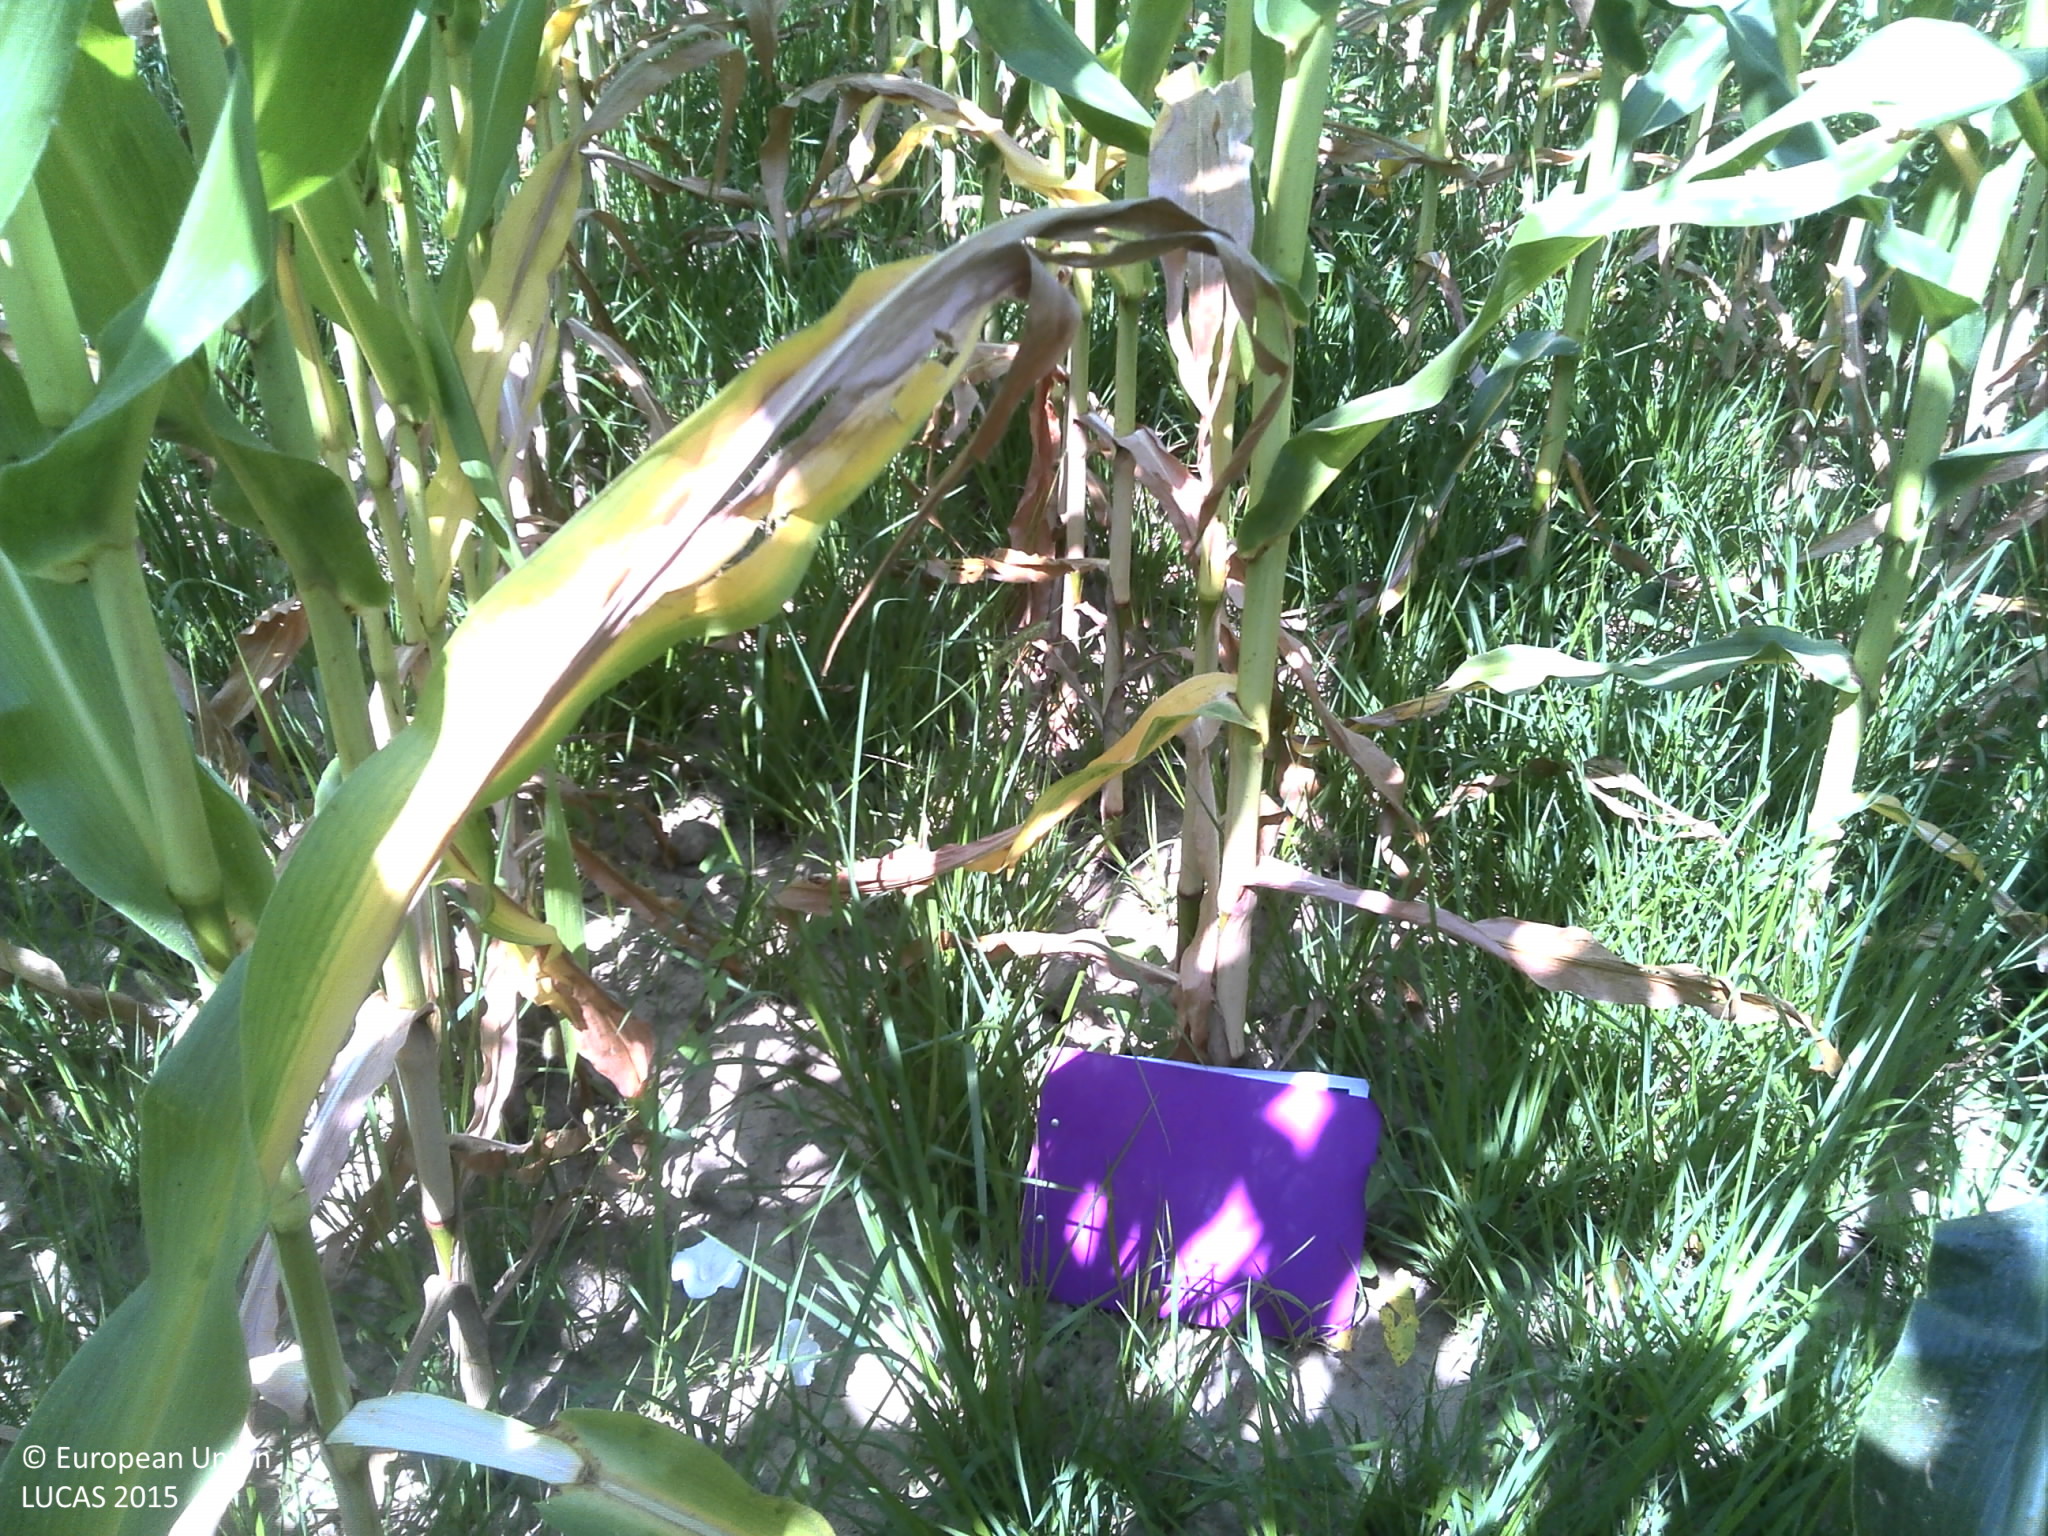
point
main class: Cropland
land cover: Maize
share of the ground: > 75 %
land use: Agriculture (excluding fallow land and kitchen gardens)
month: July
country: HR
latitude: 45.7143
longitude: 16.8728
